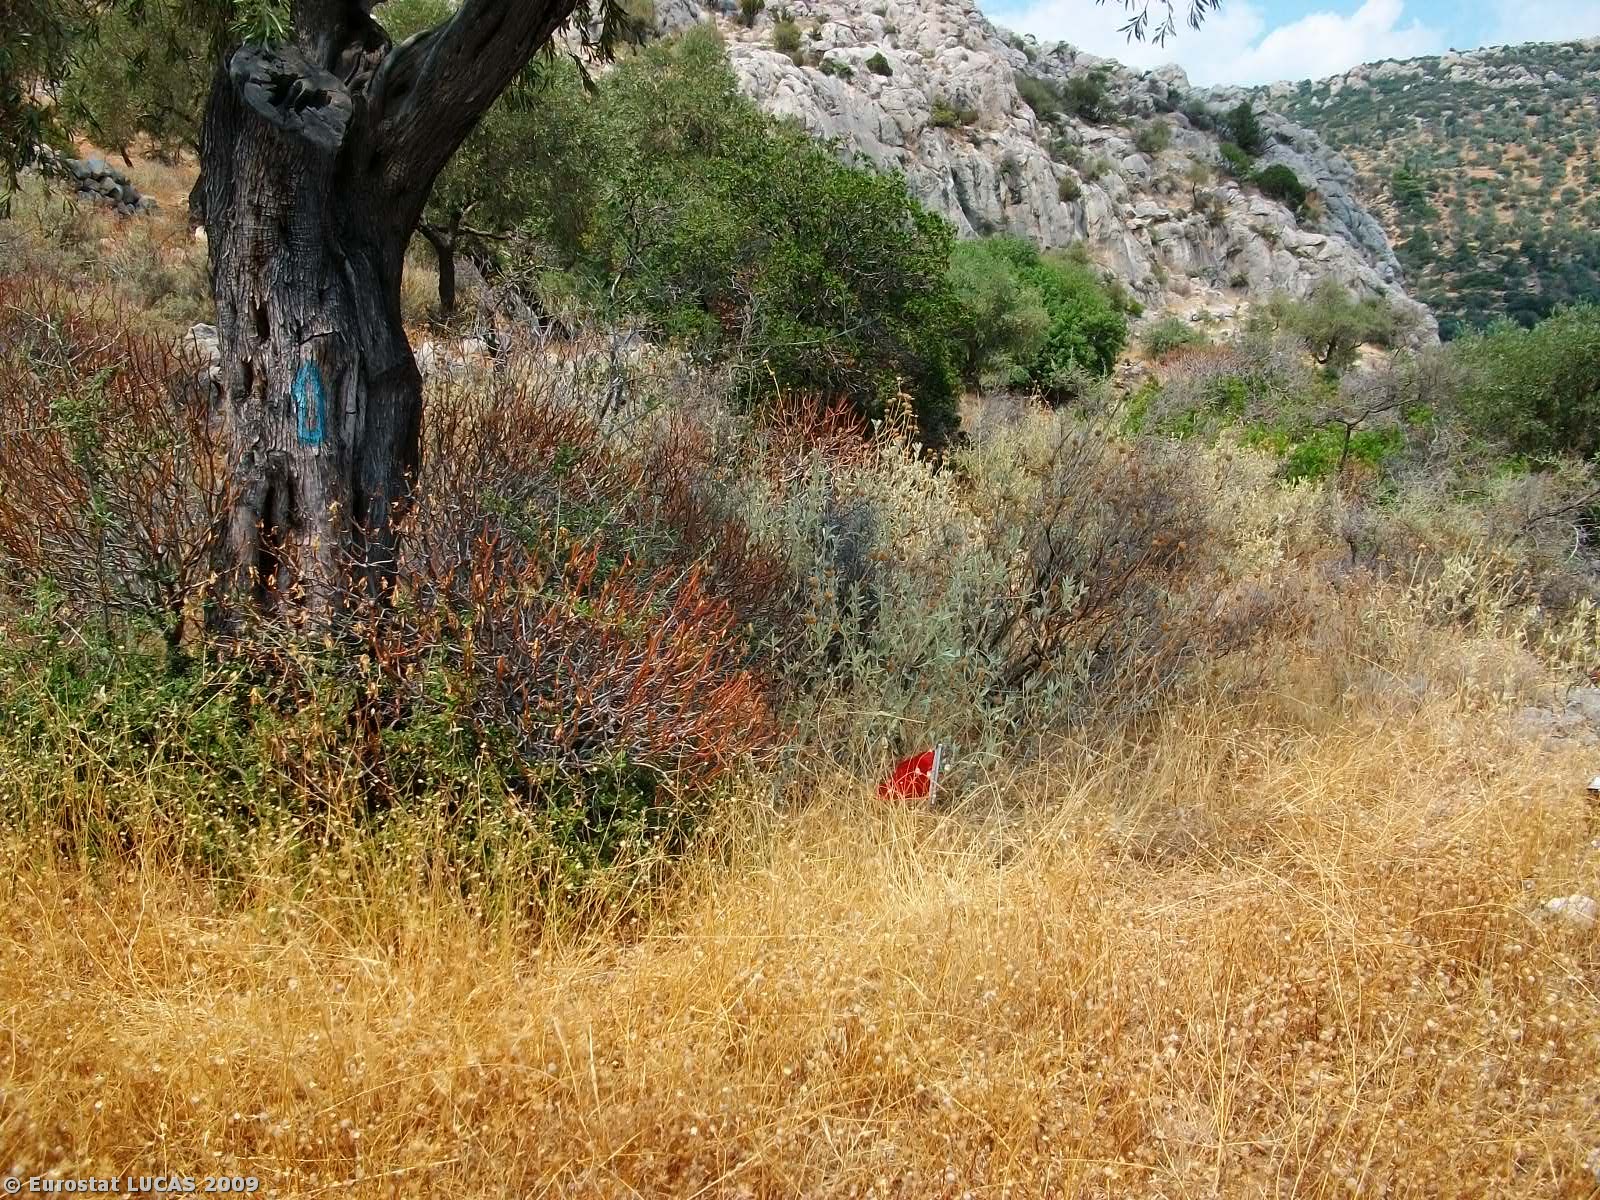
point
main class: Cropland
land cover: Olive groves
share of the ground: 10 - 25 %
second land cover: Grassland with sparse tree/shrub cover
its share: 50 - 75 %
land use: Agriculture (excluding fallow land and kitchen gardens)
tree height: < 5 m
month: July
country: GR
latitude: 38.3865
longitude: 22.6261
